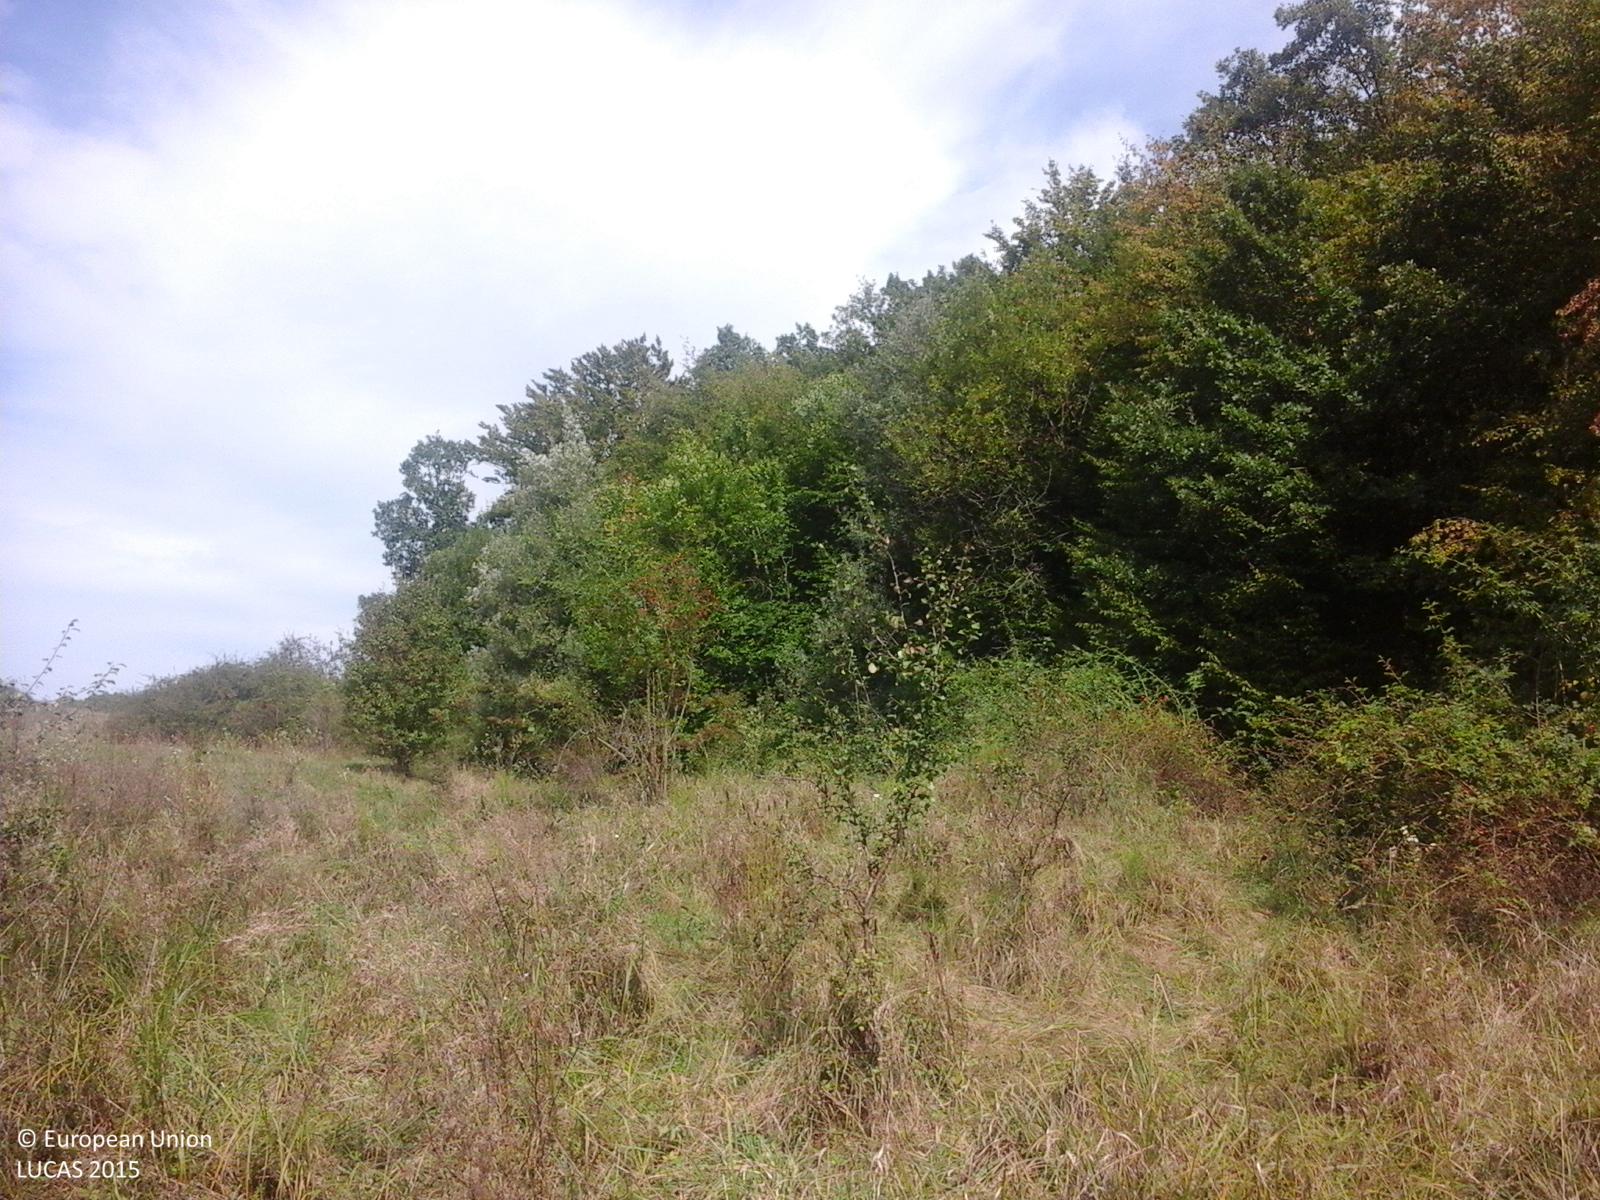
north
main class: Grassland
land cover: Grassland with sparse tree/shrub cover
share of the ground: > 75 %
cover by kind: herbaceous plants 95 %, broadleaved forest trees 5 %
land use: Fallow land
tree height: < 5 m
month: September
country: RO
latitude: 47.2471
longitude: 23.7514
